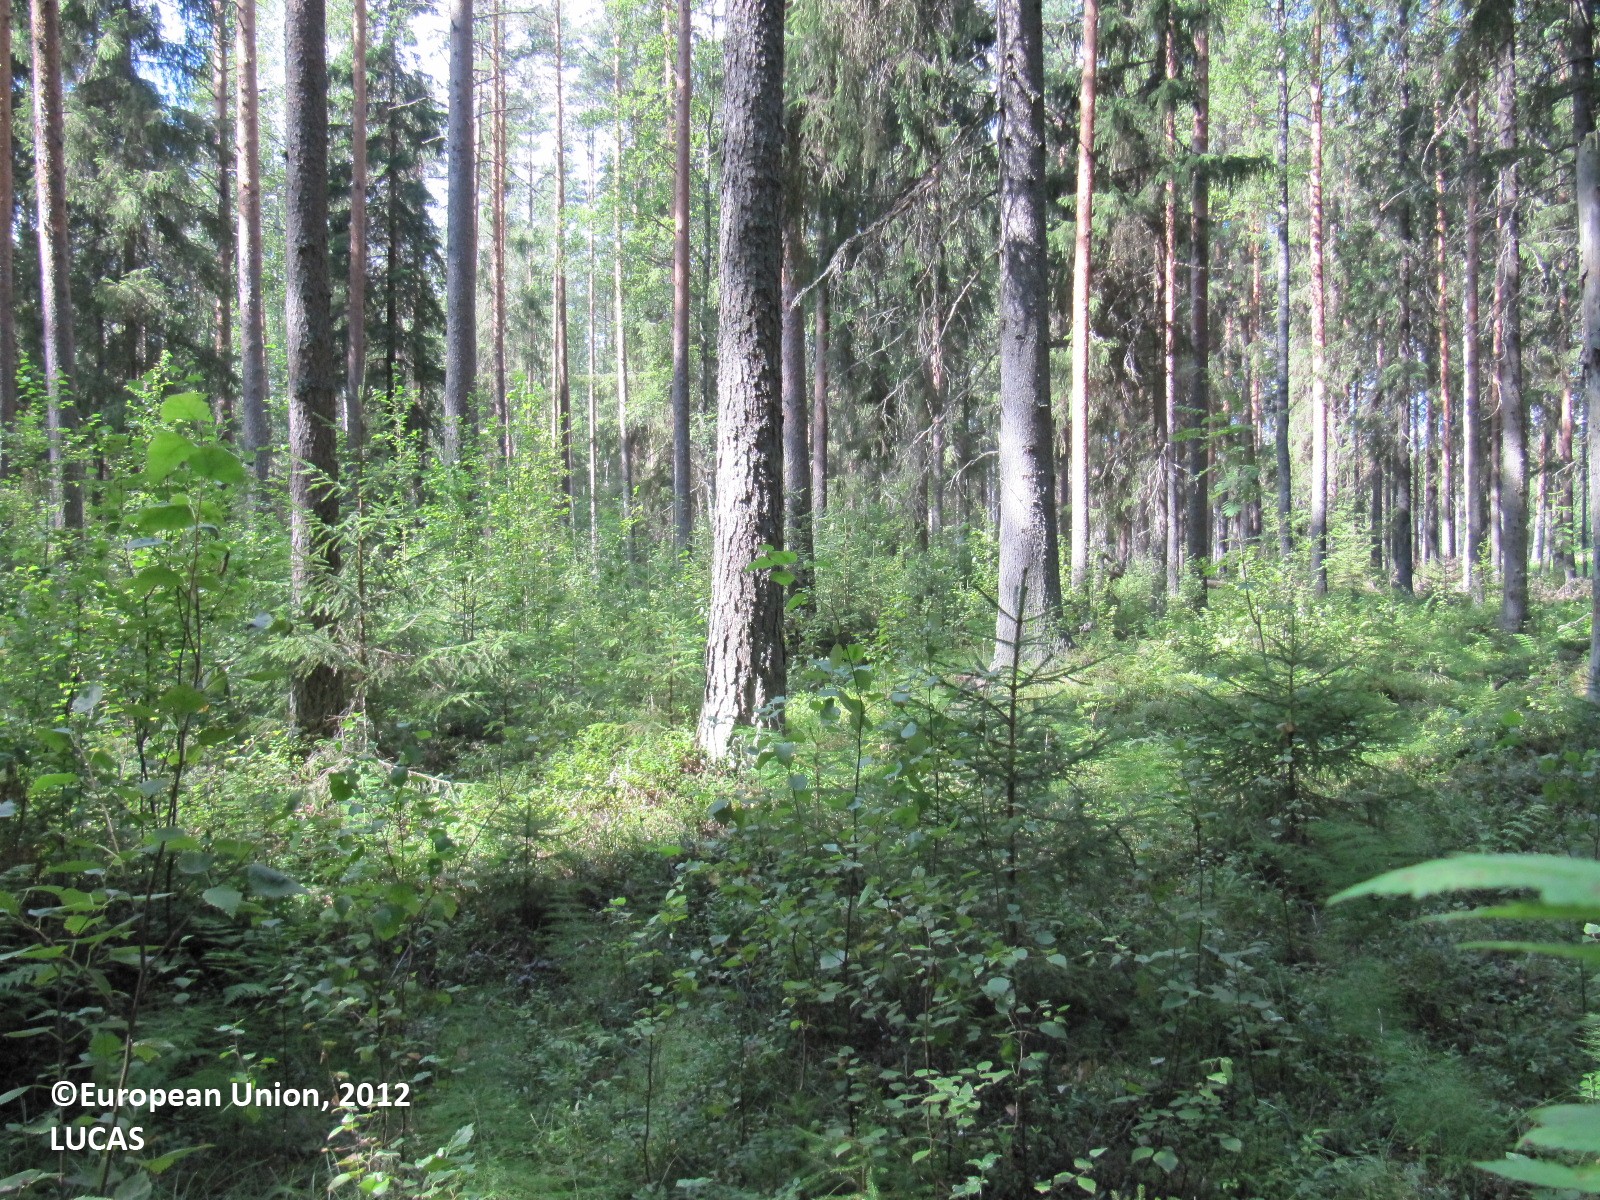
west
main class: Woodland
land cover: Spruce dominated coniferous woodland
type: boreal forest
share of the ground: > 75 %
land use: Forestry
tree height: > 5 m
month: August
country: FI
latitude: 60.7614
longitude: 24.3621
